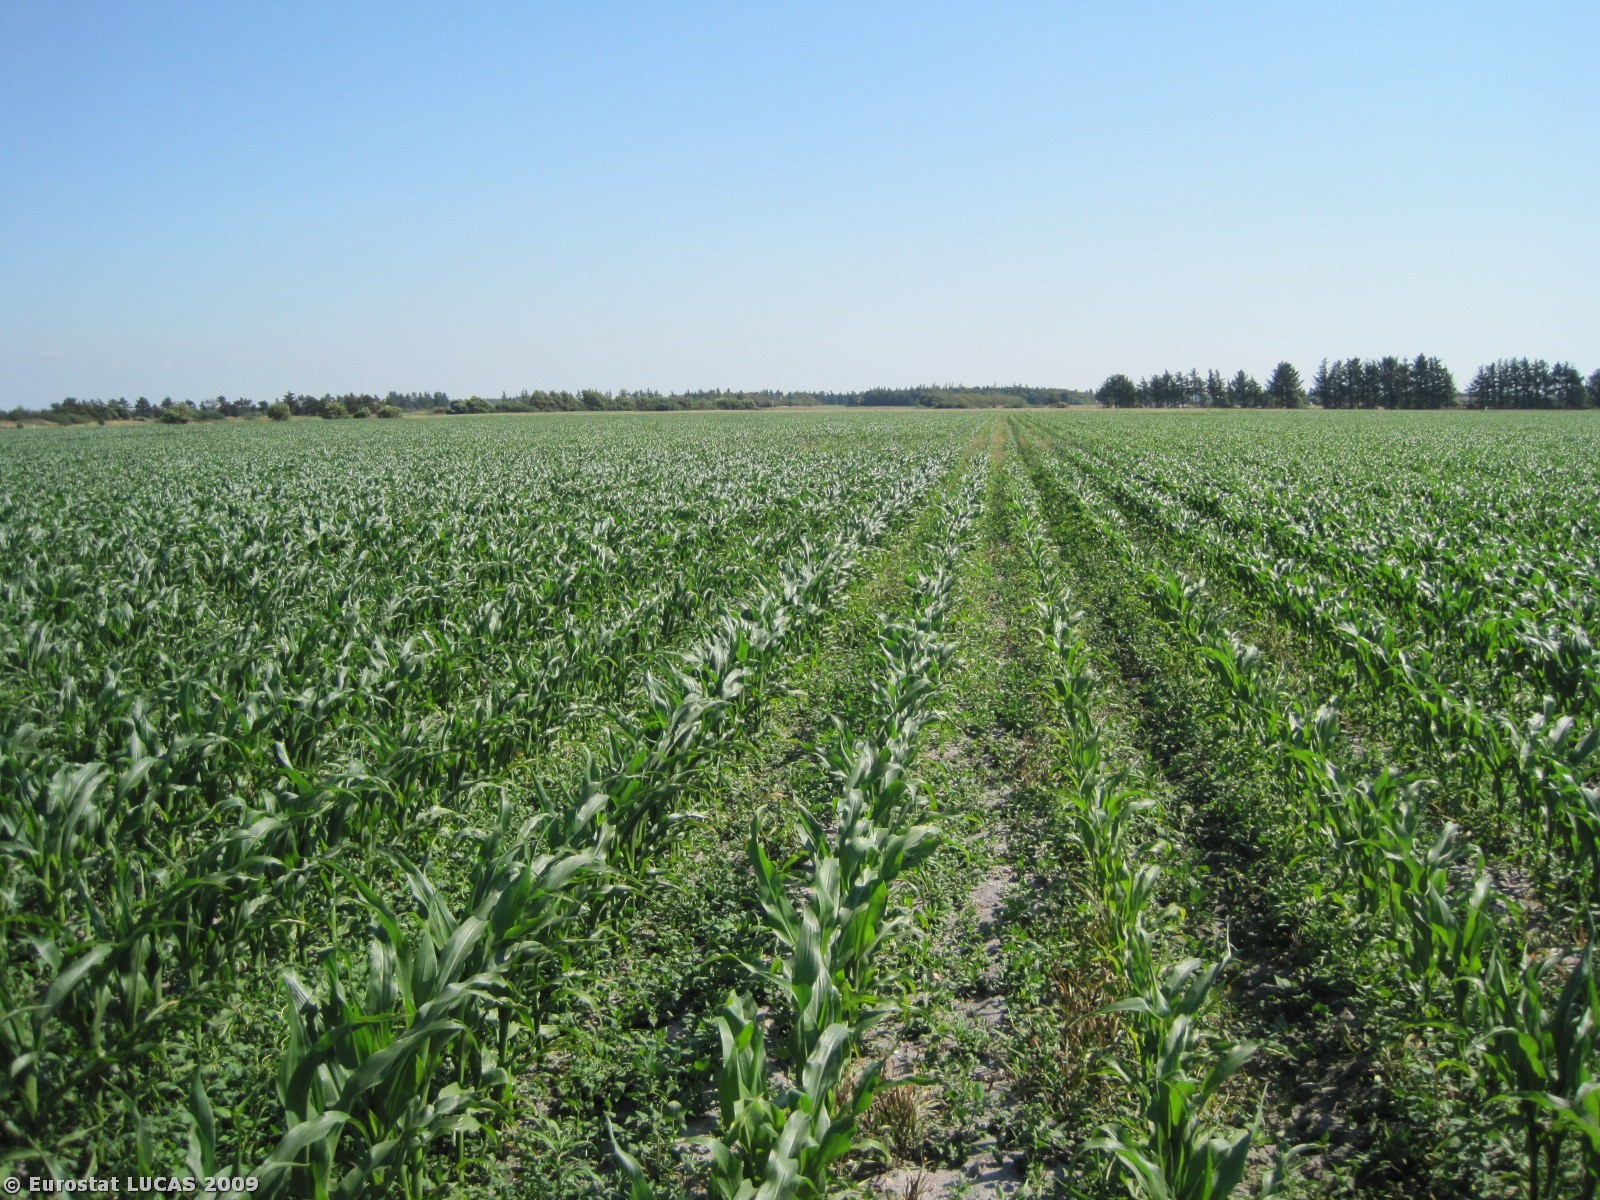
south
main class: Cropland
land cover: Maize
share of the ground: 25 - 50 %
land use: Agriculture (excluding fallow land and kitchen gardens)
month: July
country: DK
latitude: 56.3939
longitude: 8.4305
